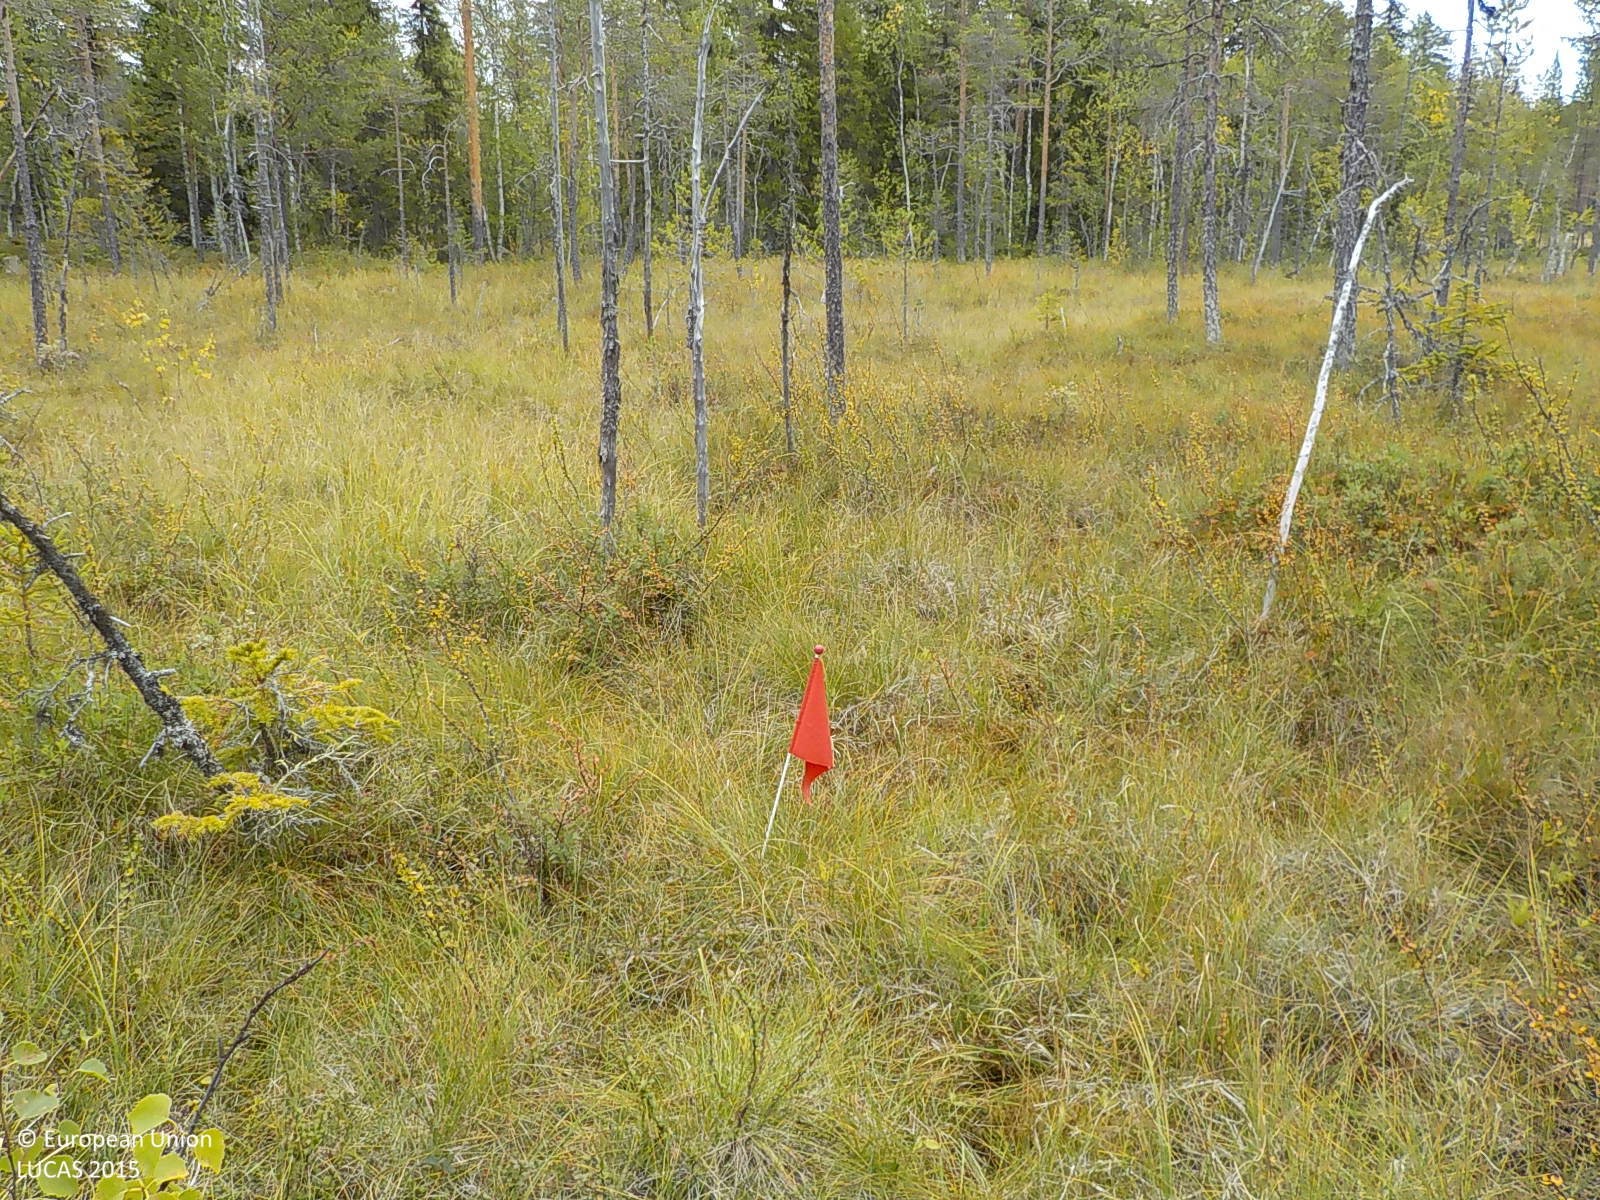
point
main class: Woodland
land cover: Pine dominated coniferous woodland
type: boreal forest
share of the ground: 10 - 25 %
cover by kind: herbaceous plants 80 %, coniferous forest trees 15 %, shrubs 5 %
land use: Semi-natural and natural areas not in use
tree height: > 5 m
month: September
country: SE
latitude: 63.3986
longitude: 17.2405
